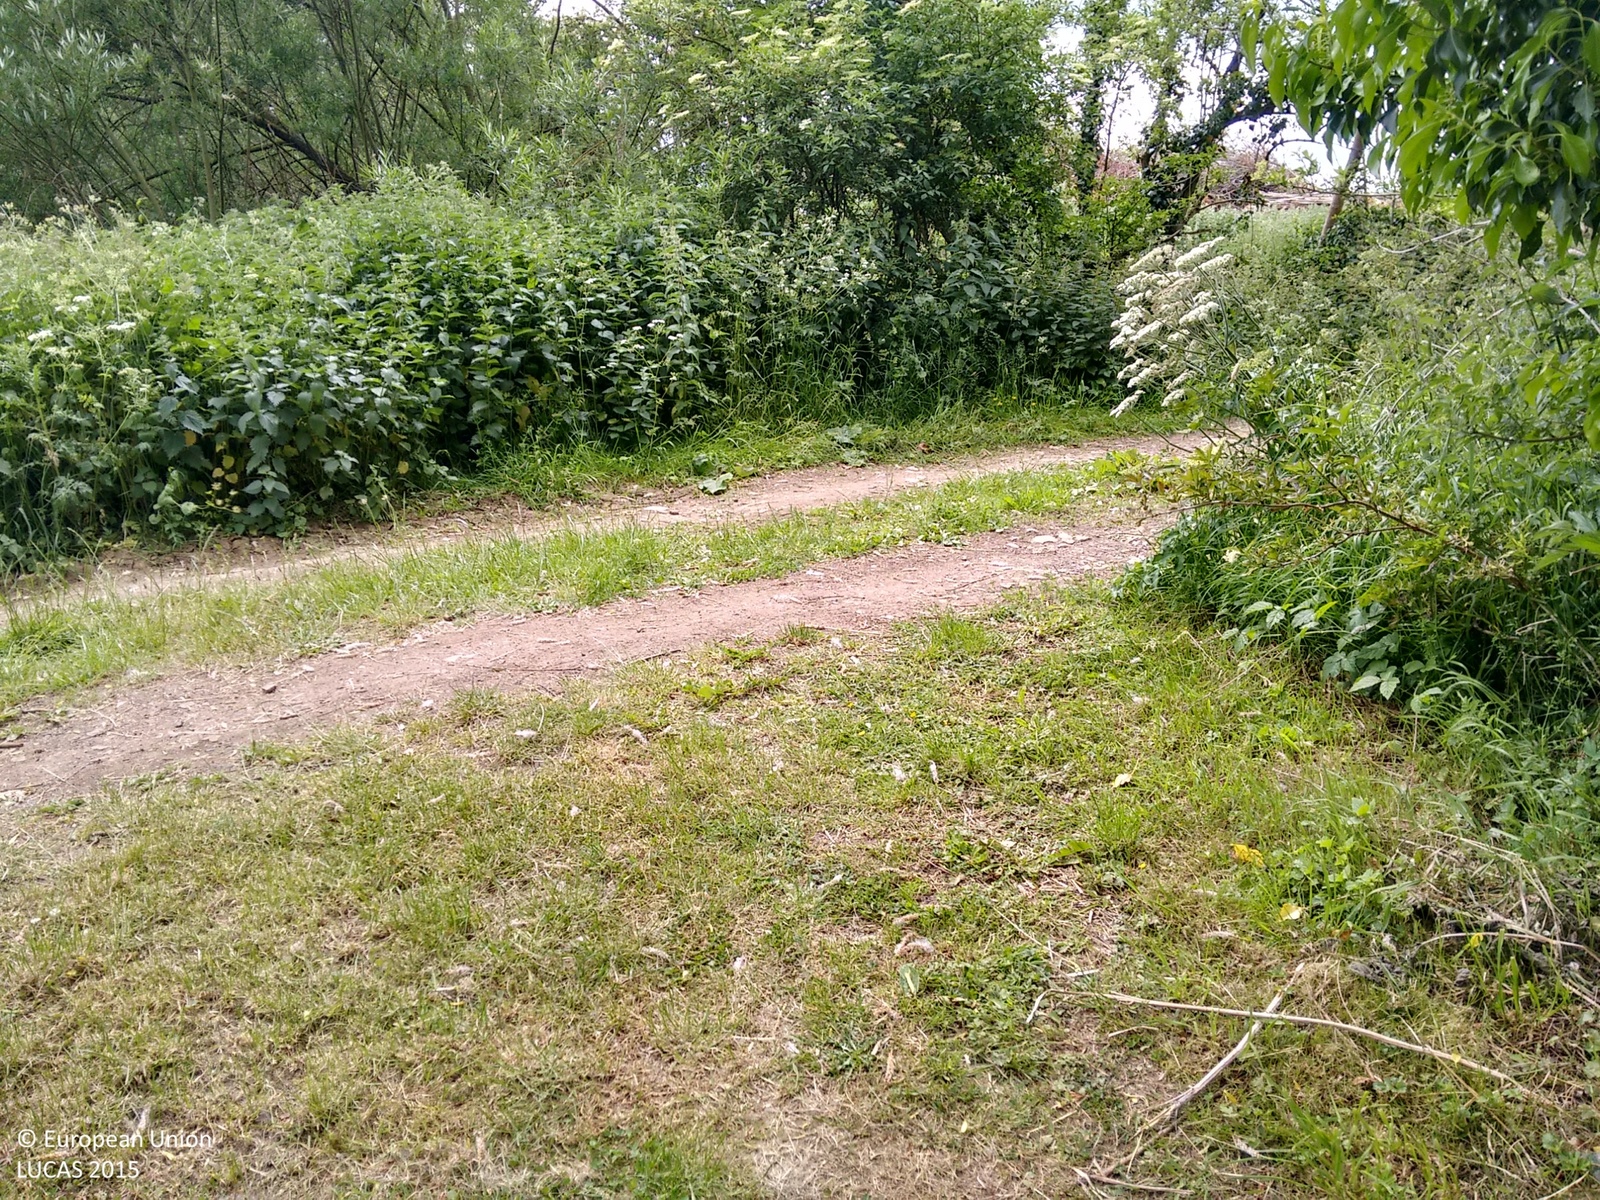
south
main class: Grassland
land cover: Grassland with sparse tree/shrub cover
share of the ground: > 75 %
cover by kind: herbaceous plants 95 %, broadleaved forest trees 5 %
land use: Agriculture (excluding fallow land and kitchen gardens)
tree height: > 5 m
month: June
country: GB
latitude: 52.1122
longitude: -1.6327
